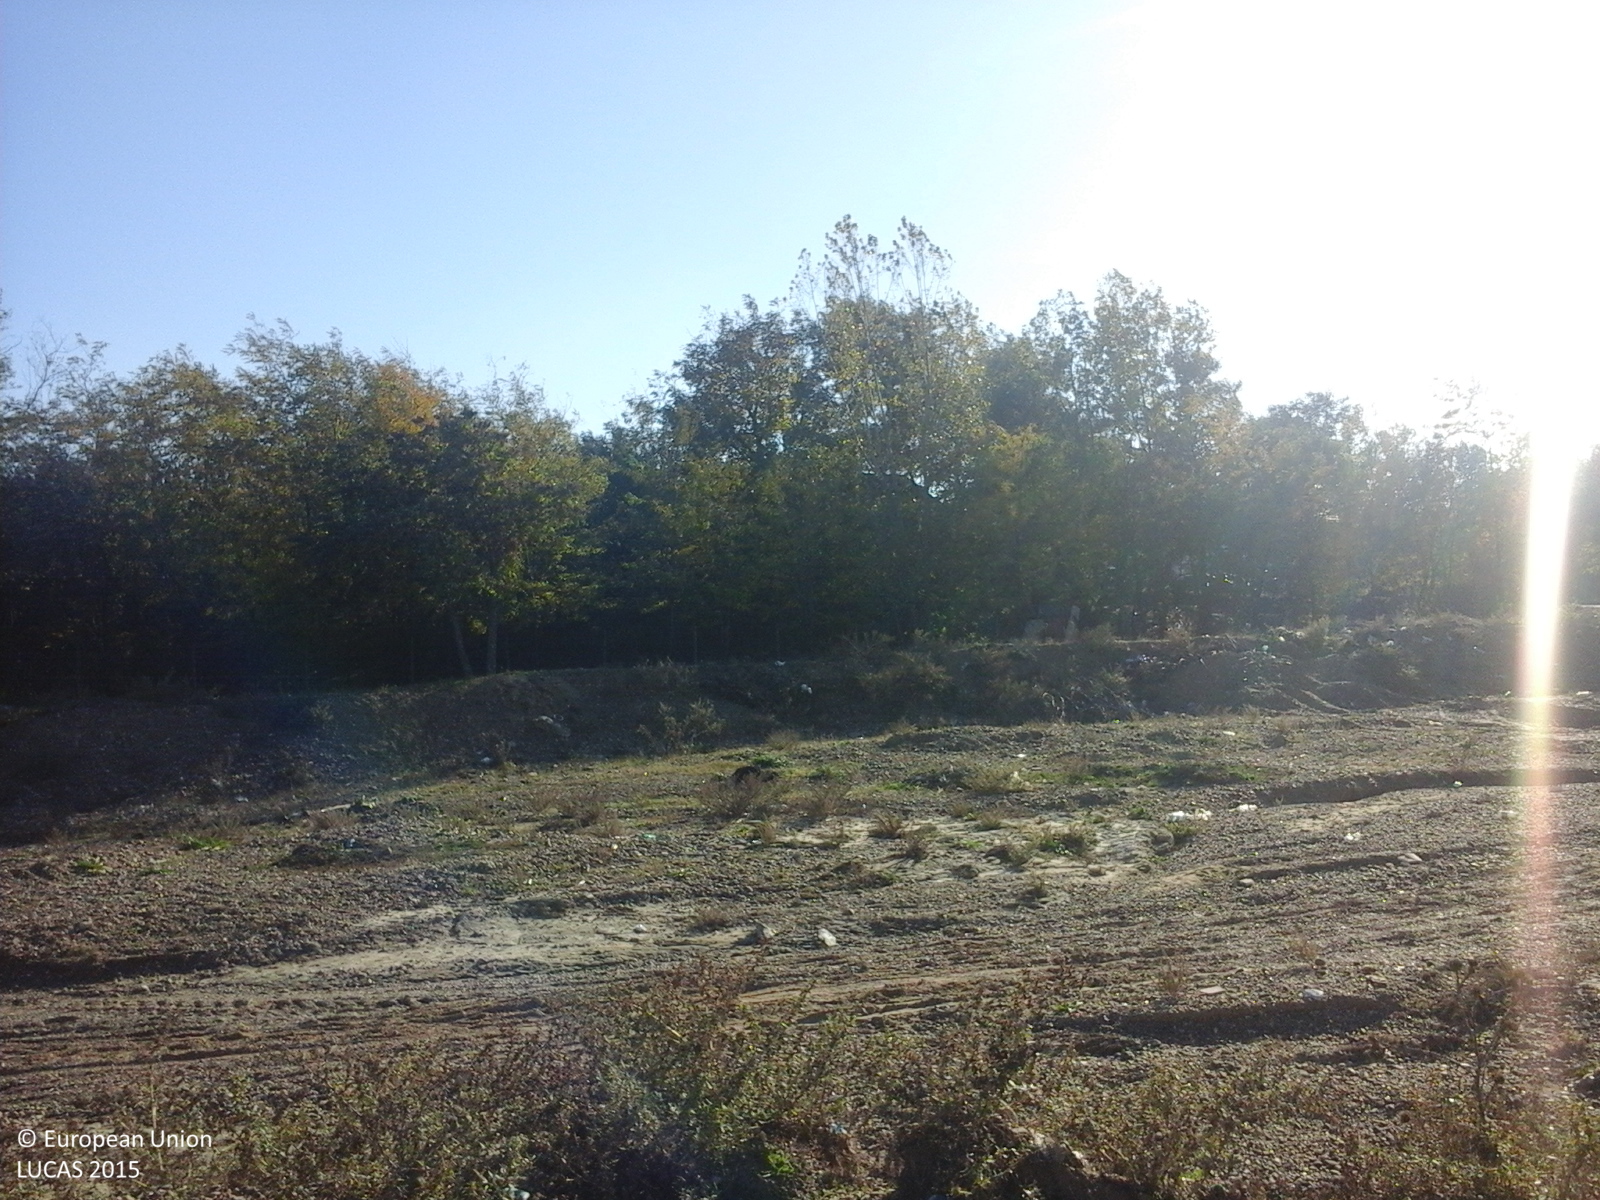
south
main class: Grassland
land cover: Spontaneously vegetated surfaces
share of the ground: > 75 %
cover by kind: herbaceous plants 100 %
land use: Fallow land
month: October
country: RO
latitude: 46.0789
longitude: 27.1262
